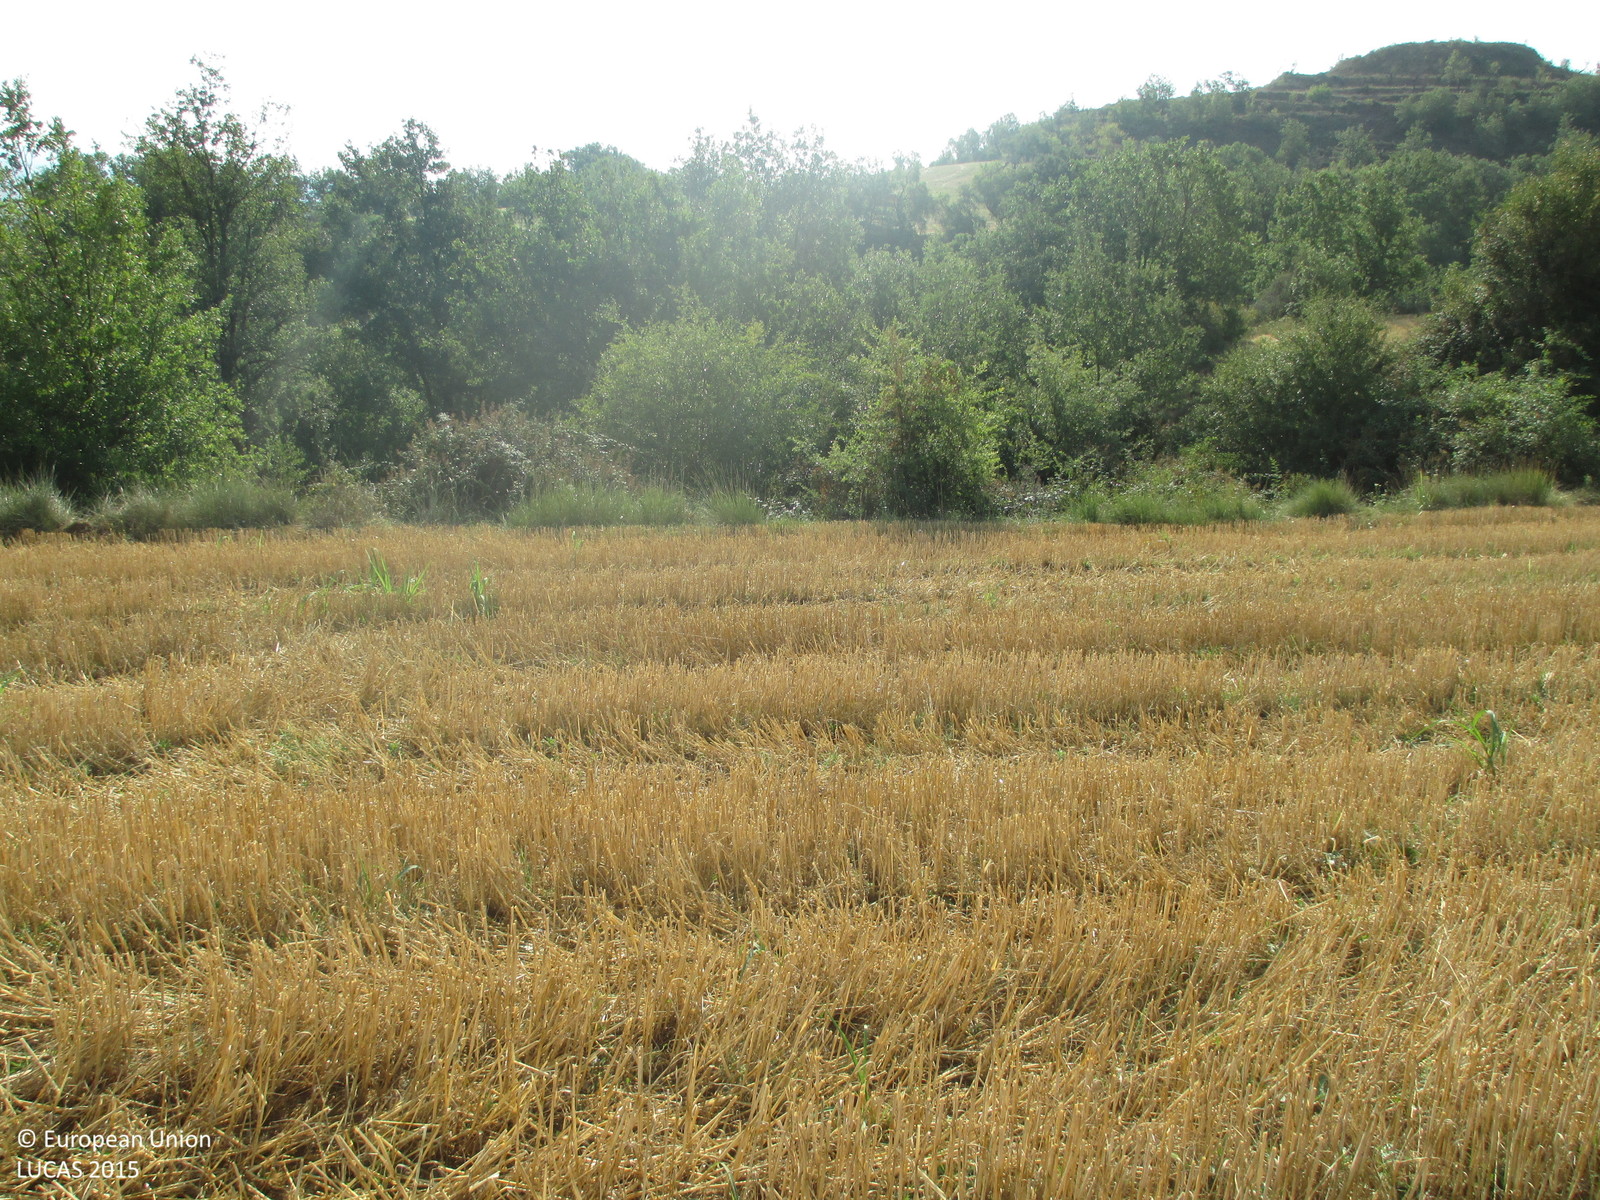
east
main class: Cropland
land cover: Common wheat
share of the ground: < 10 %
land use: Agriculture (excluding fallow land and kitchen gardens)
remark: Harvested field
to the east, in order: Common wheat; Broadleaved woodland; Rivers and streams; Broadleaved woodland; Barley
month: July
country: ES
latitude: 42.1188
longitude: 0.3424
